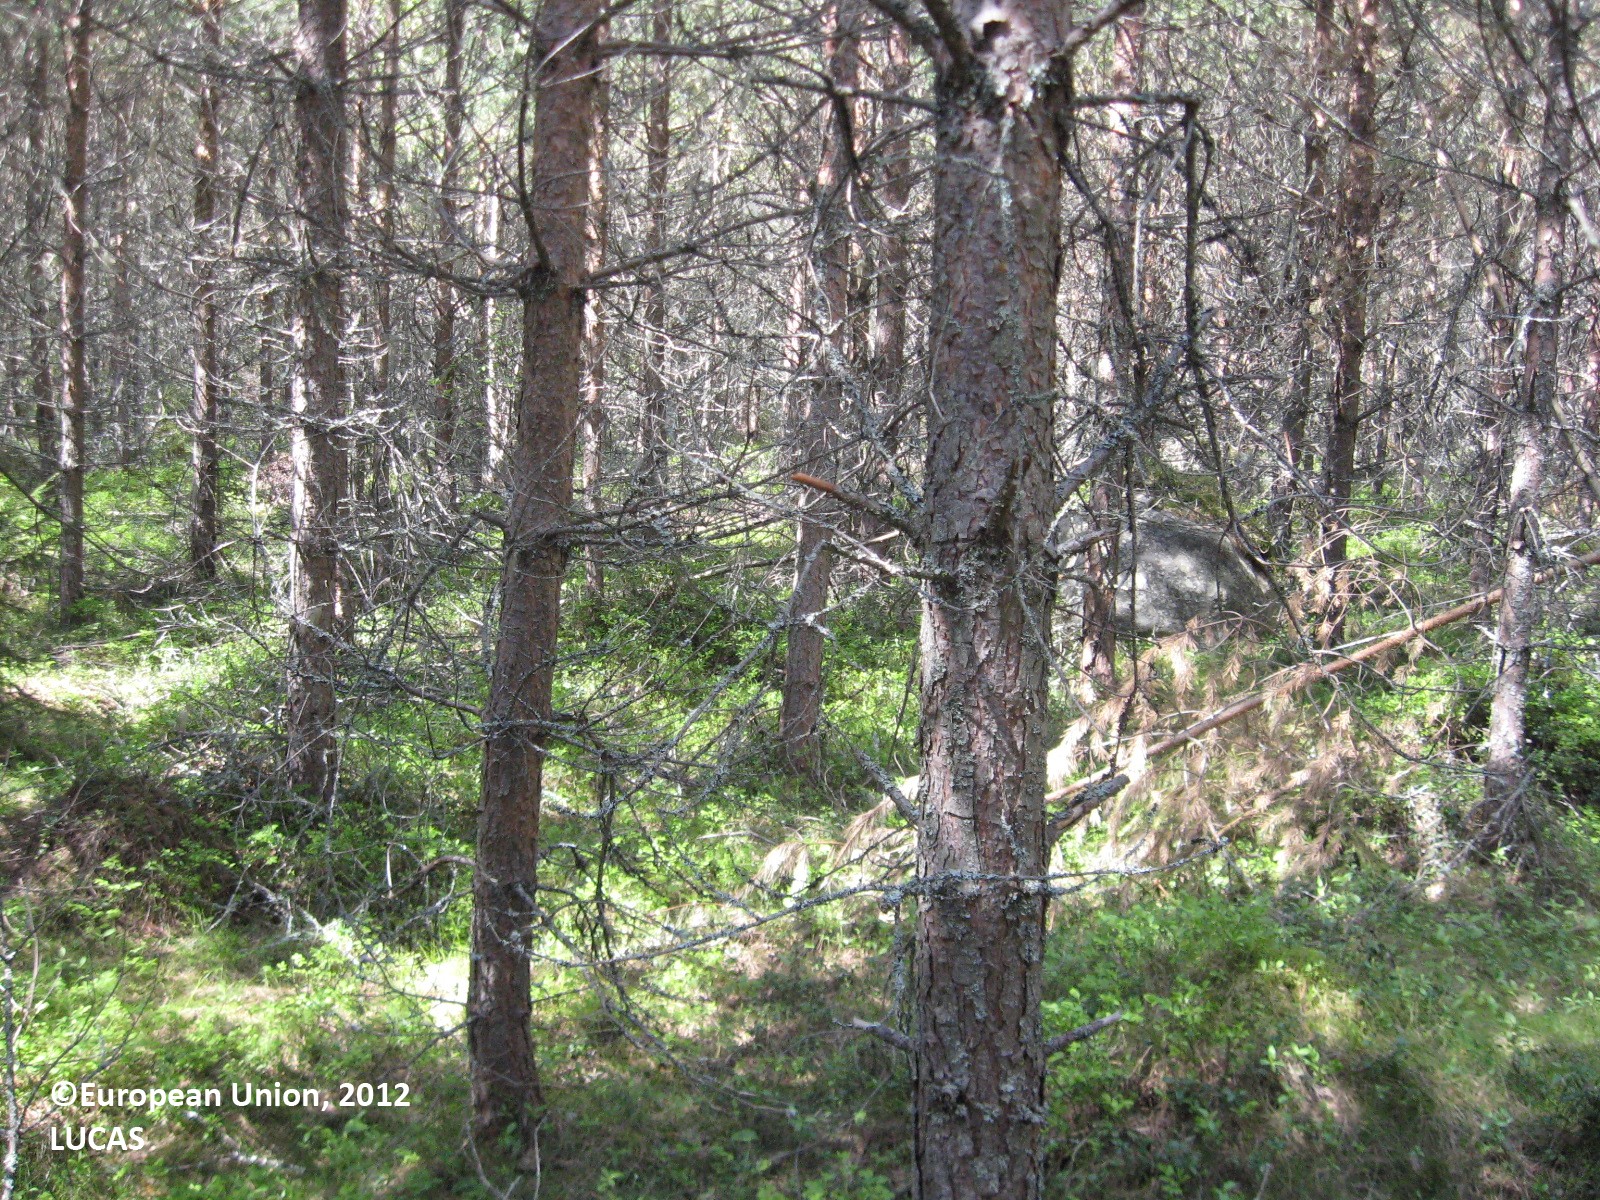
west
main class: Woodland
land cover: Pine dominated coniferous woodland
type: boreal forest
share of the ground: > 75 %
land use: Forestry
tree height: > 5 m
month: June
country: FI
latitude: 63.2161
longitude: 21.4346
